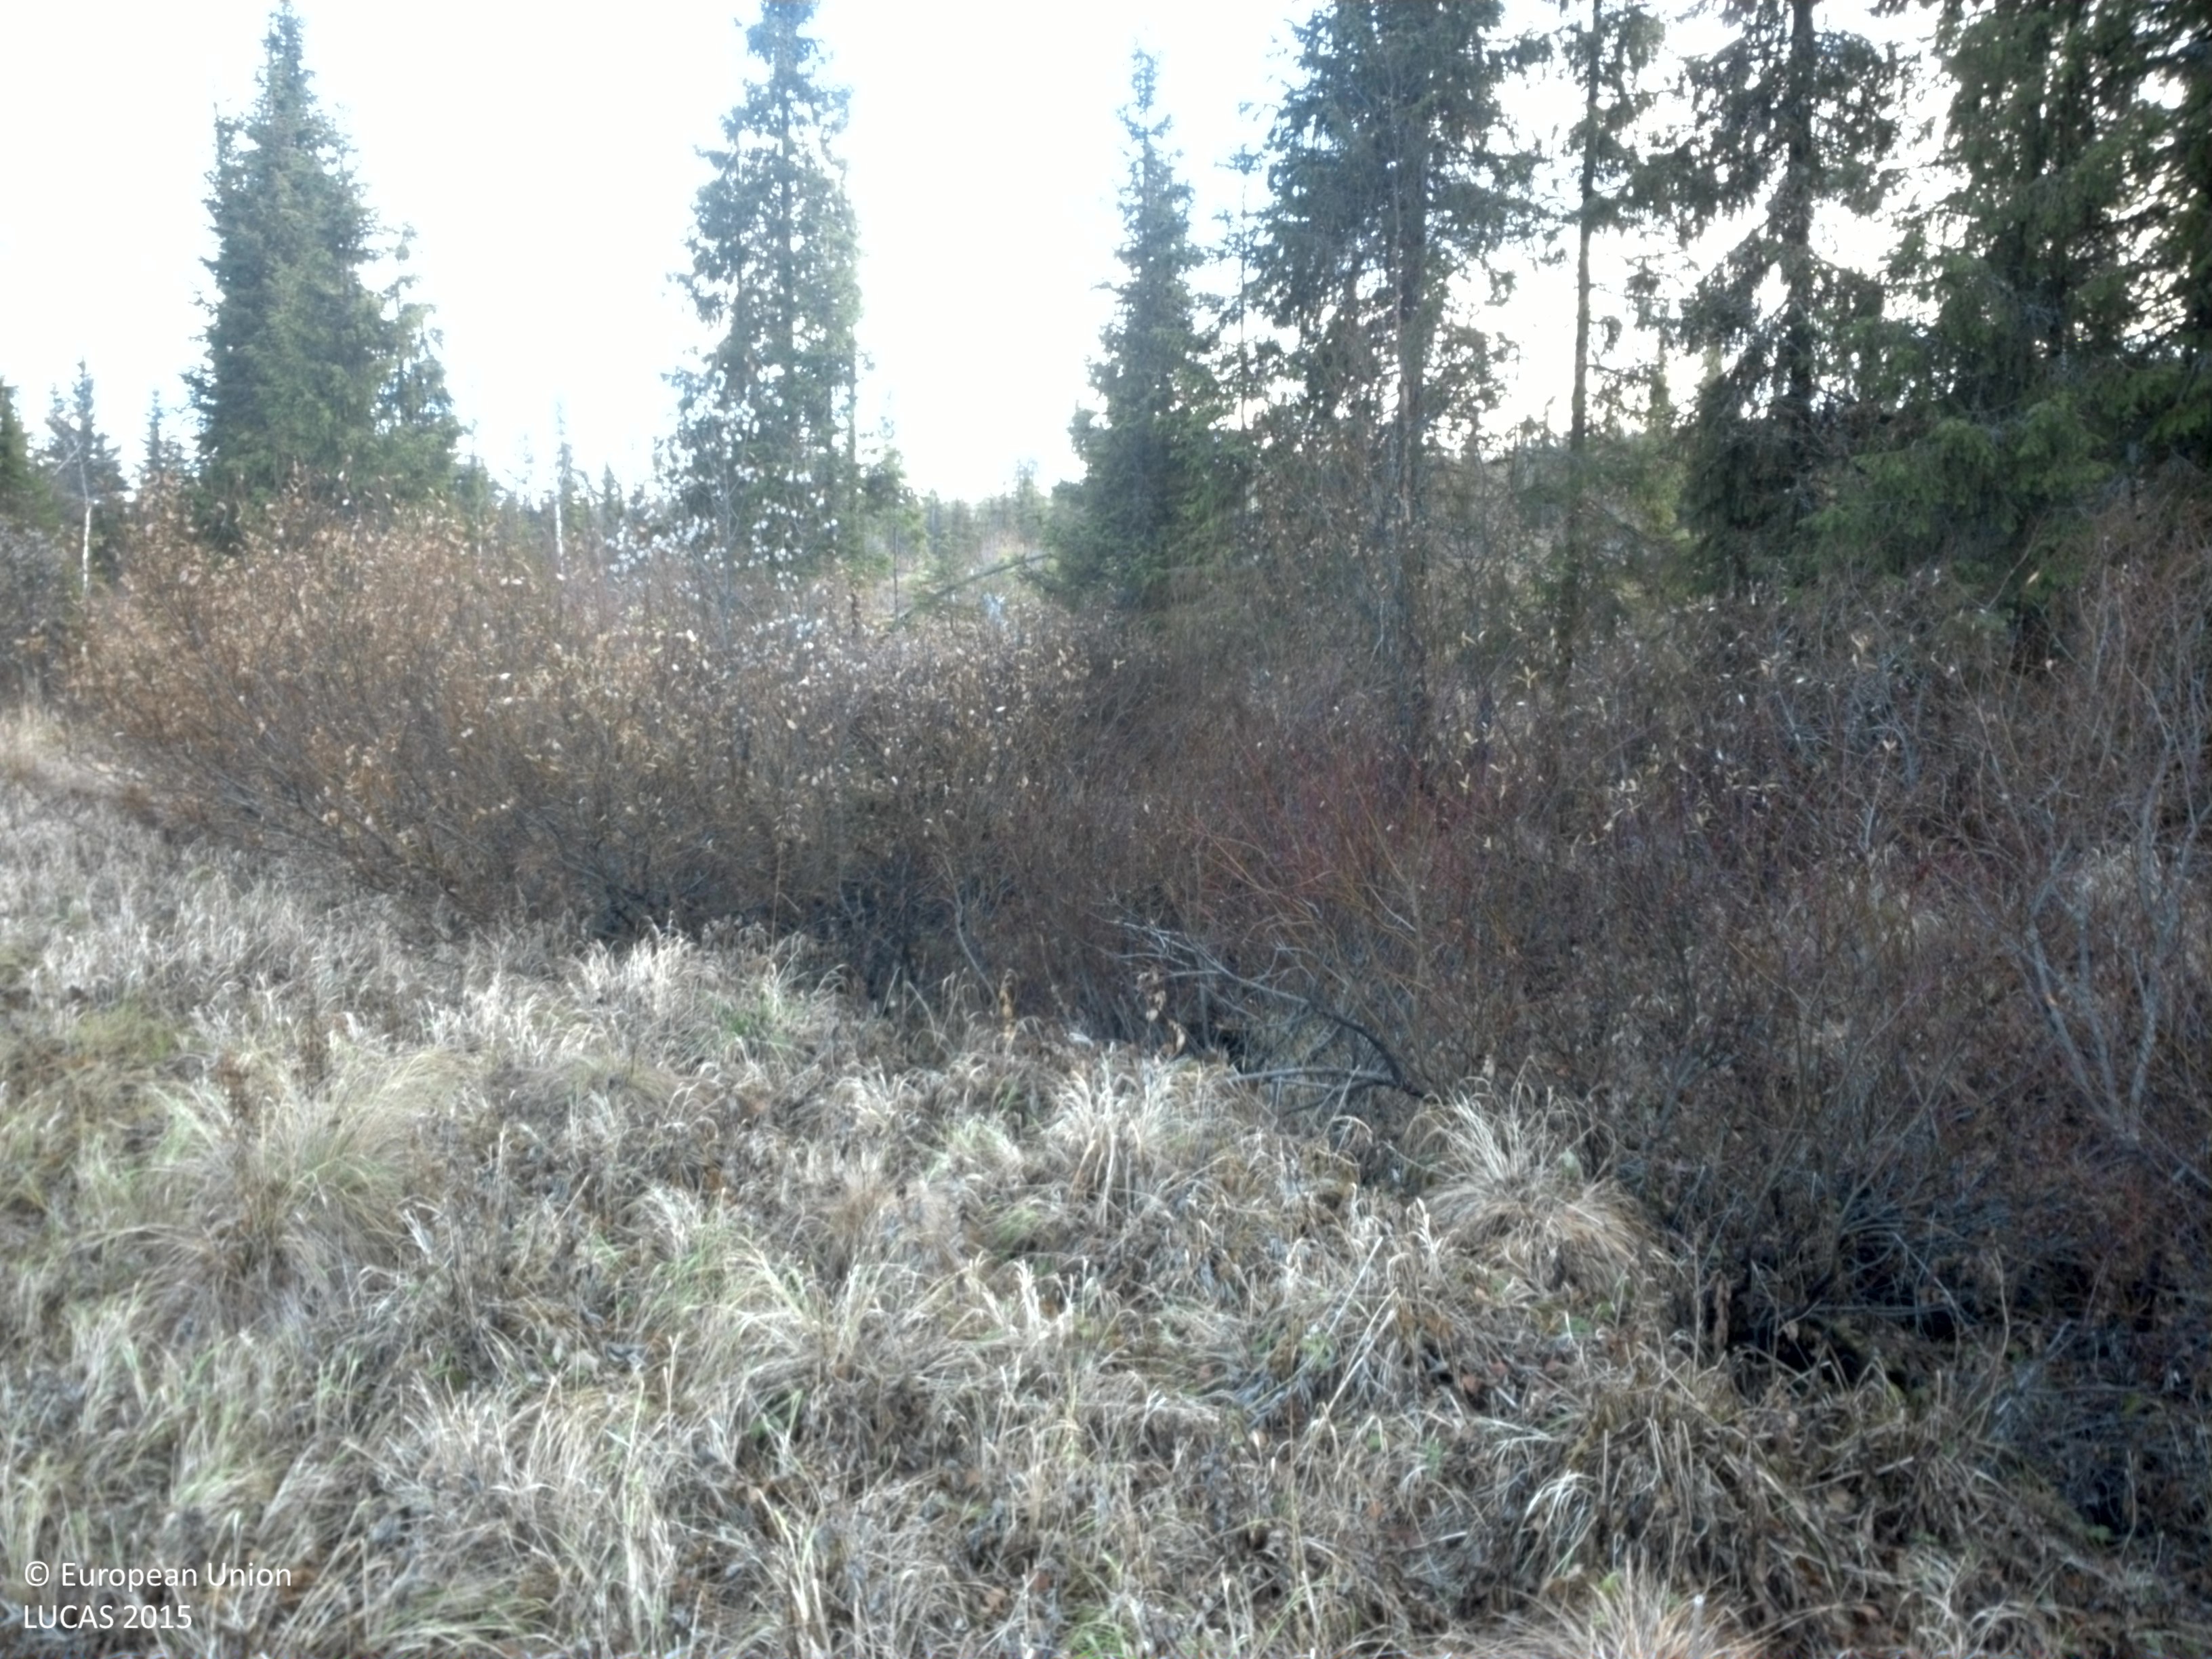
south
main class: Grassland
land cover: Grassland without tree/shrub cover
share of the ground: > 75 %
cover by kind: herbaceous plants 100 %
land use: Abandoned areas
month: October
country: SE
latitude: 64.6419
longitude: 17.0188
